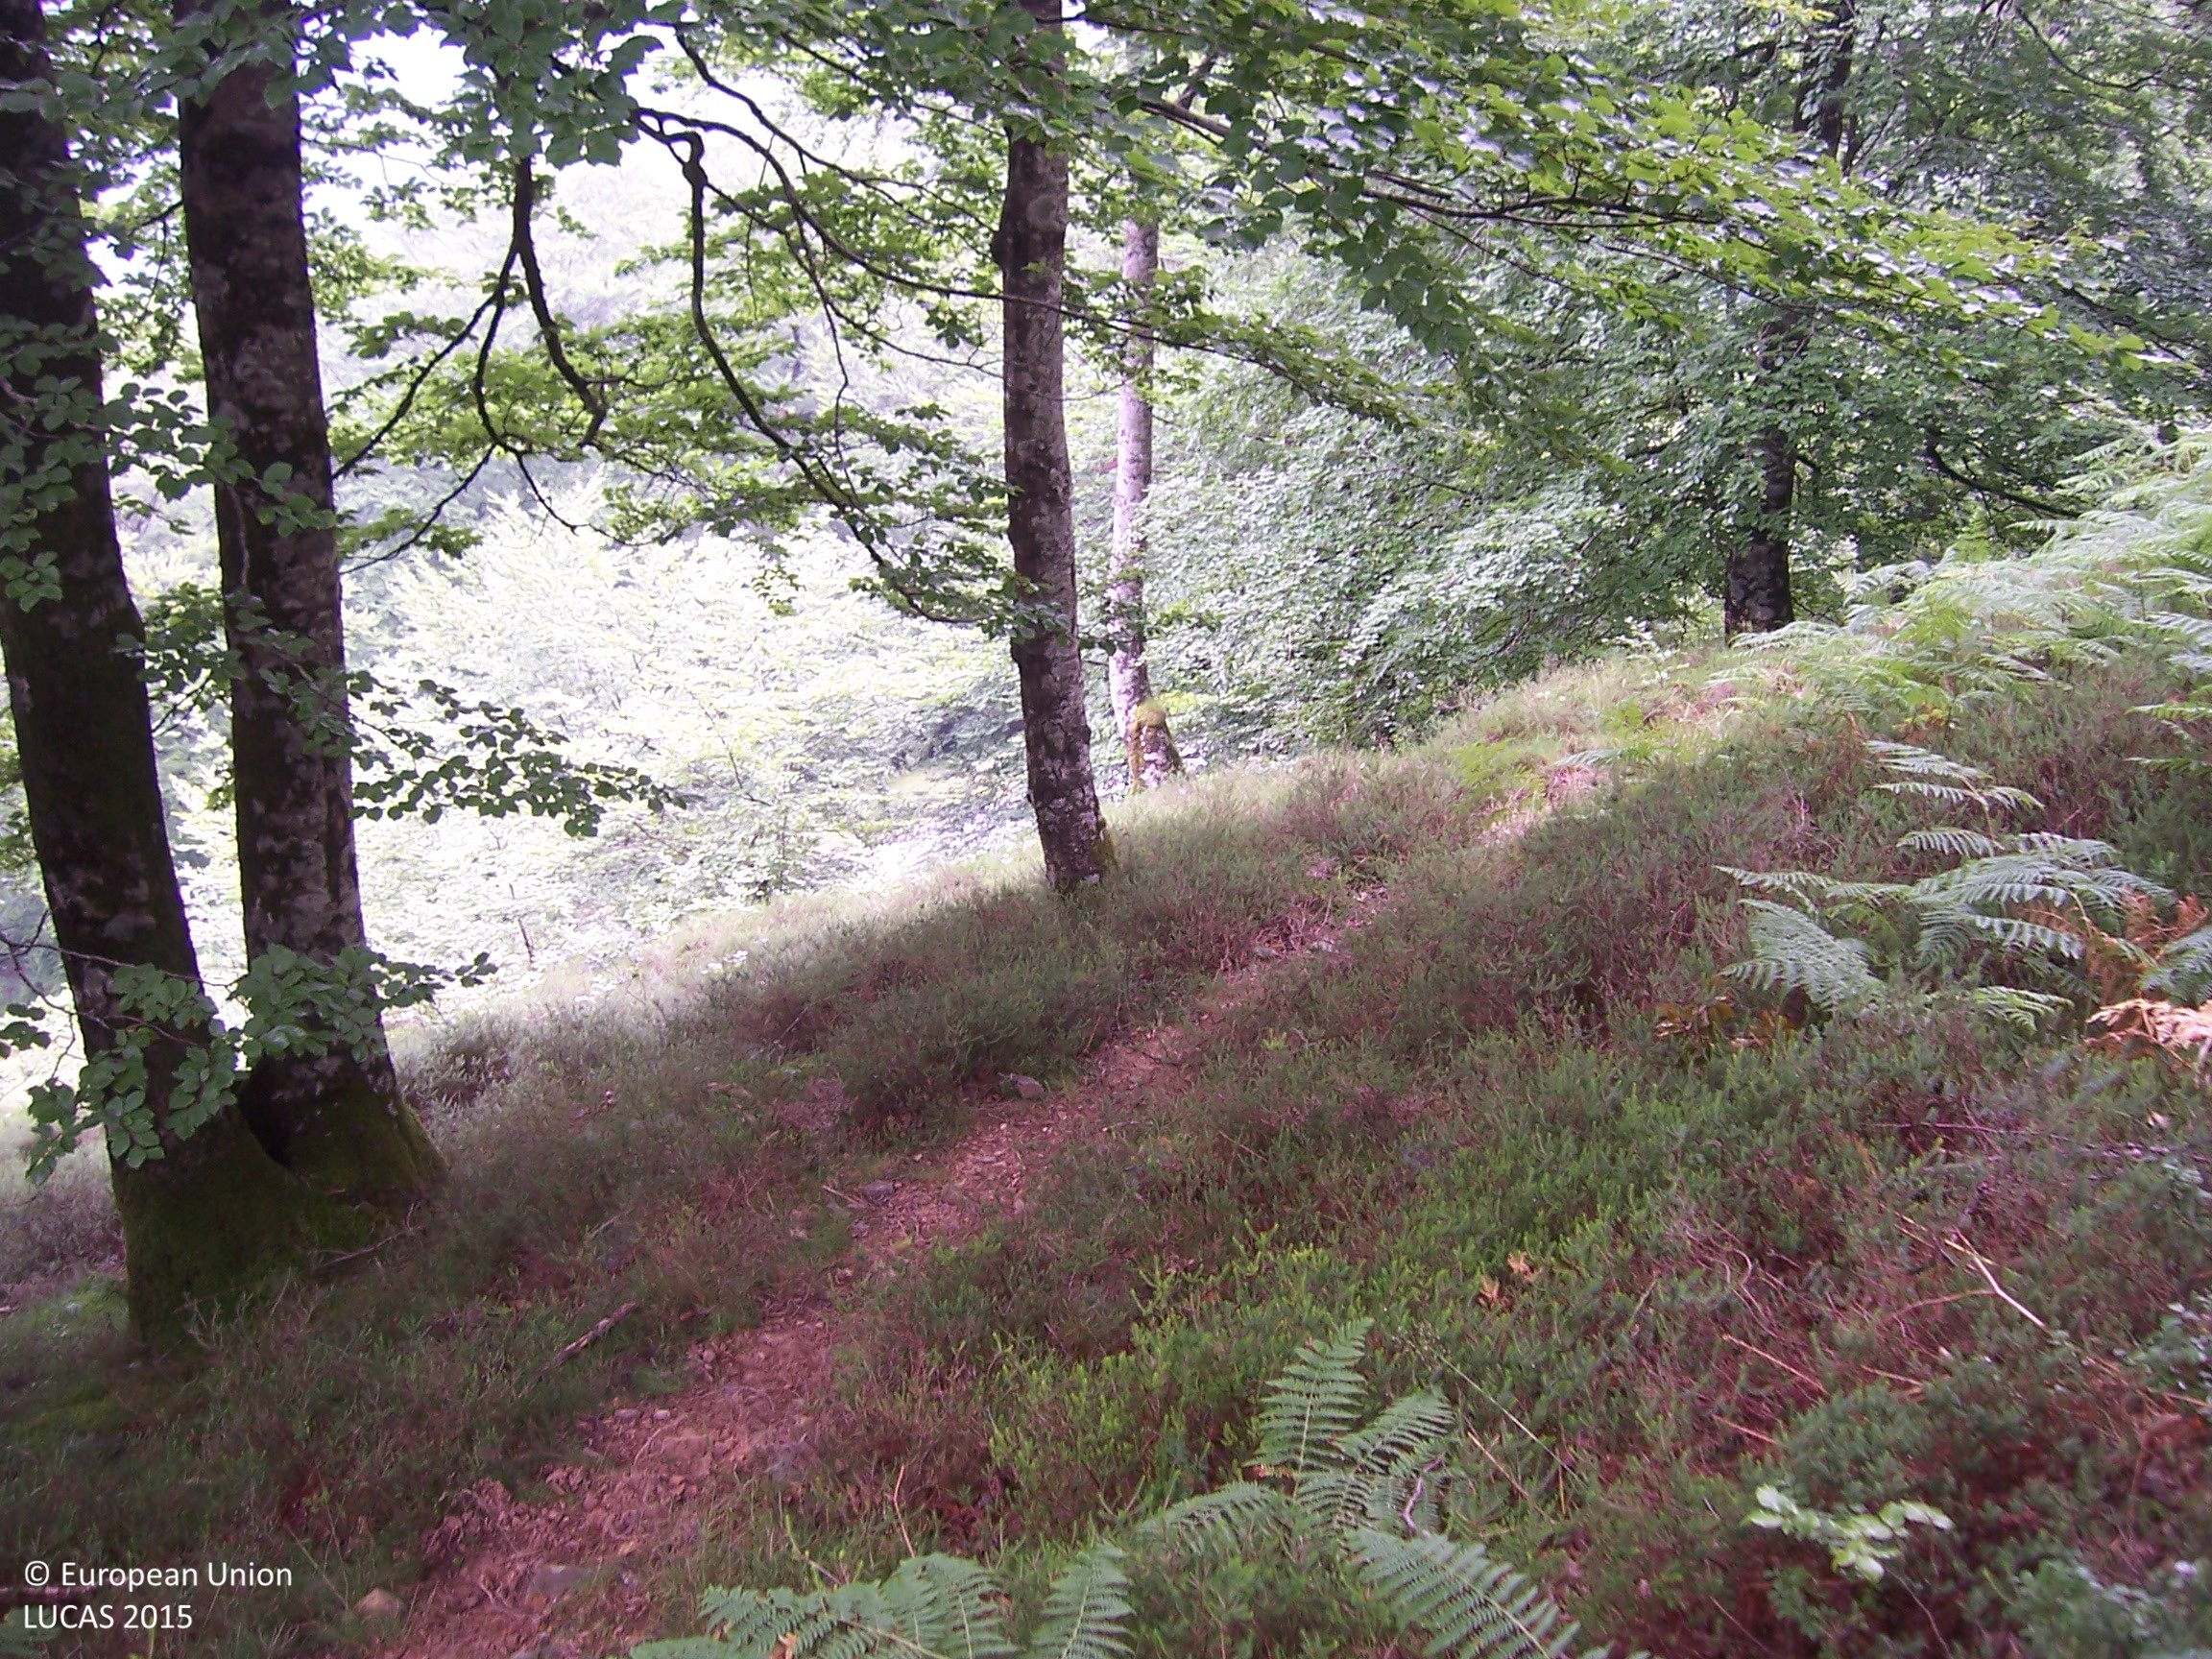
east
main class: Woodland
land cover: Broadleaved woodland
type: beech forest
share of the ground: > 75 %
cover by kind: broadleaved forest trees 90 %, herbaceous plants 10 %
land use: Forestry
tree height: > 5 m
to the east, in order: Broadleaved woodland; Grass margins; Paved roads, cycling and walking lanes; Broadleaved woodland; Grass margins; Paved roads, cycling and walking lanes; Grass margins; Fences; Broadleaved woodland
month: July
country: ES
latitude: 43.0691
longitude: -1.5223
